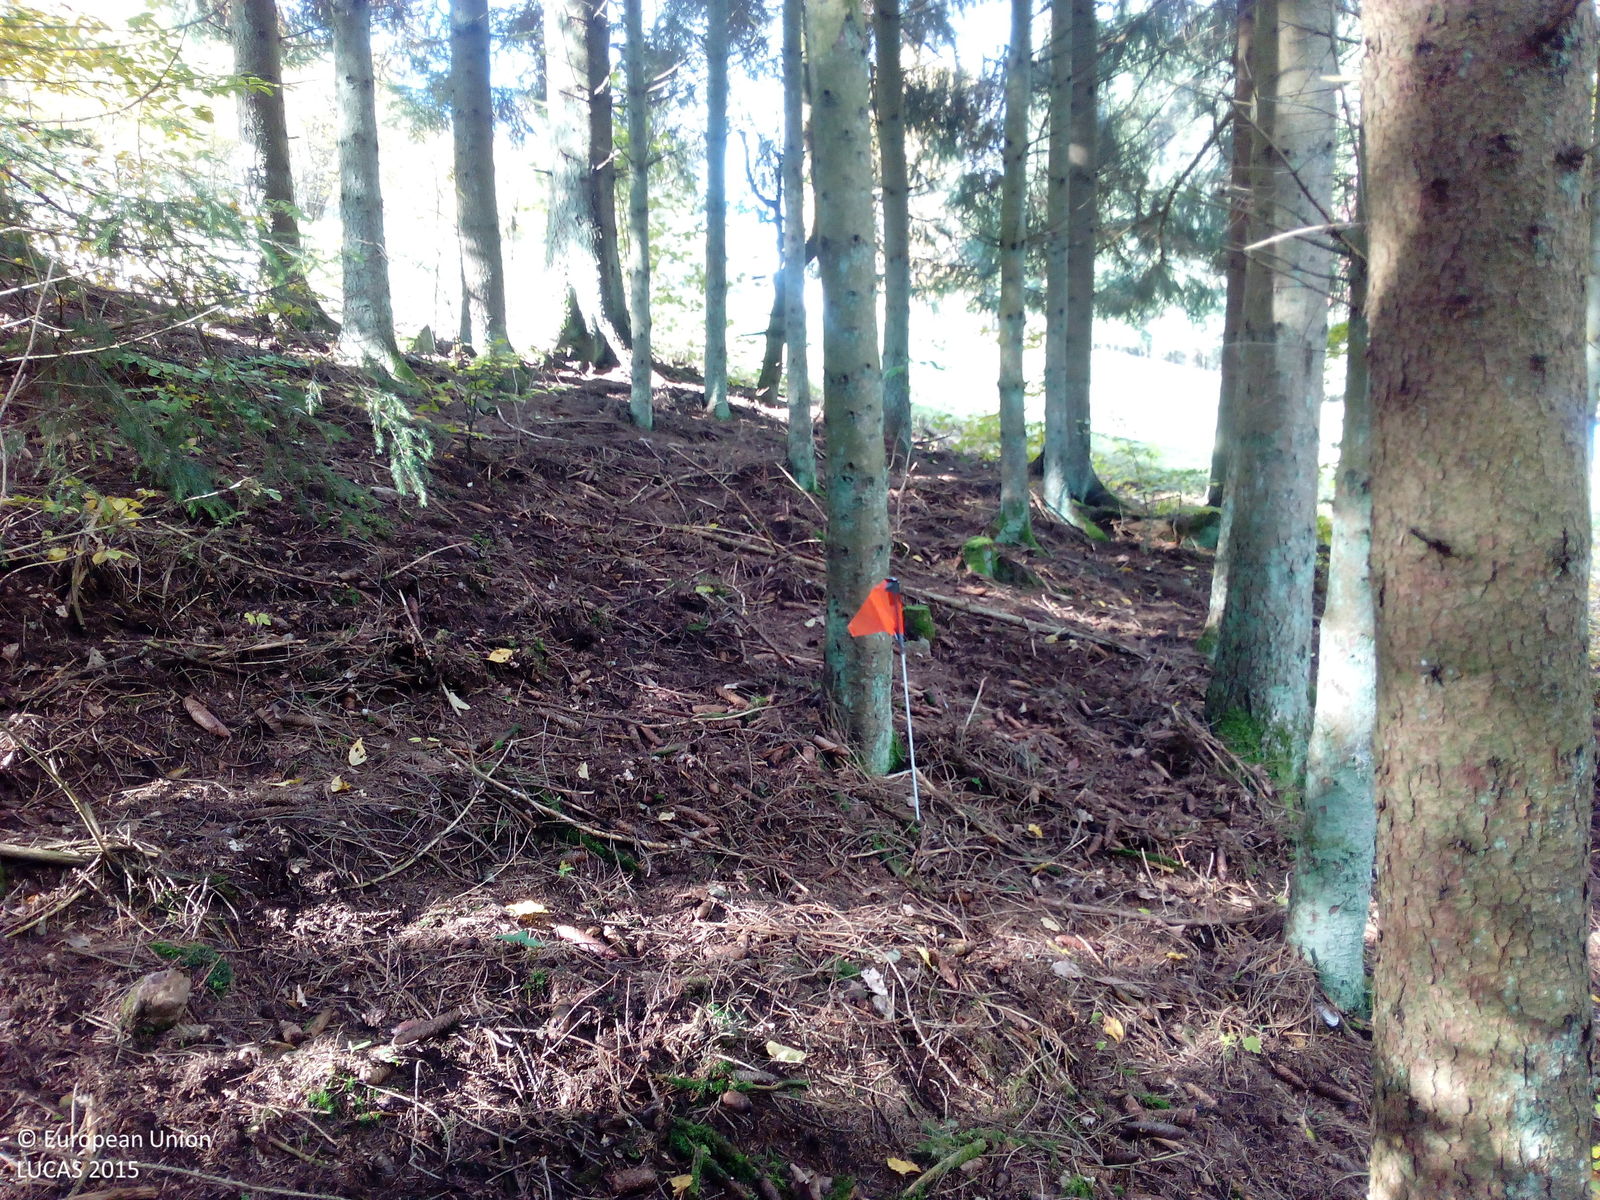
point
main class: Woodland
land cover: Spruce dominated coniferous woodland
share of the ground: 50 - 75 %
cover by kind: coniferous forest trees 65 %, unconsolidated bare surface 15 %, lichens and mosses 10 %, broadleaved forest trees 5 %, shrubs 5 %
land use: Forestry
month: October
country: DE
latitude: 50.3460
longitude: 9.8736
